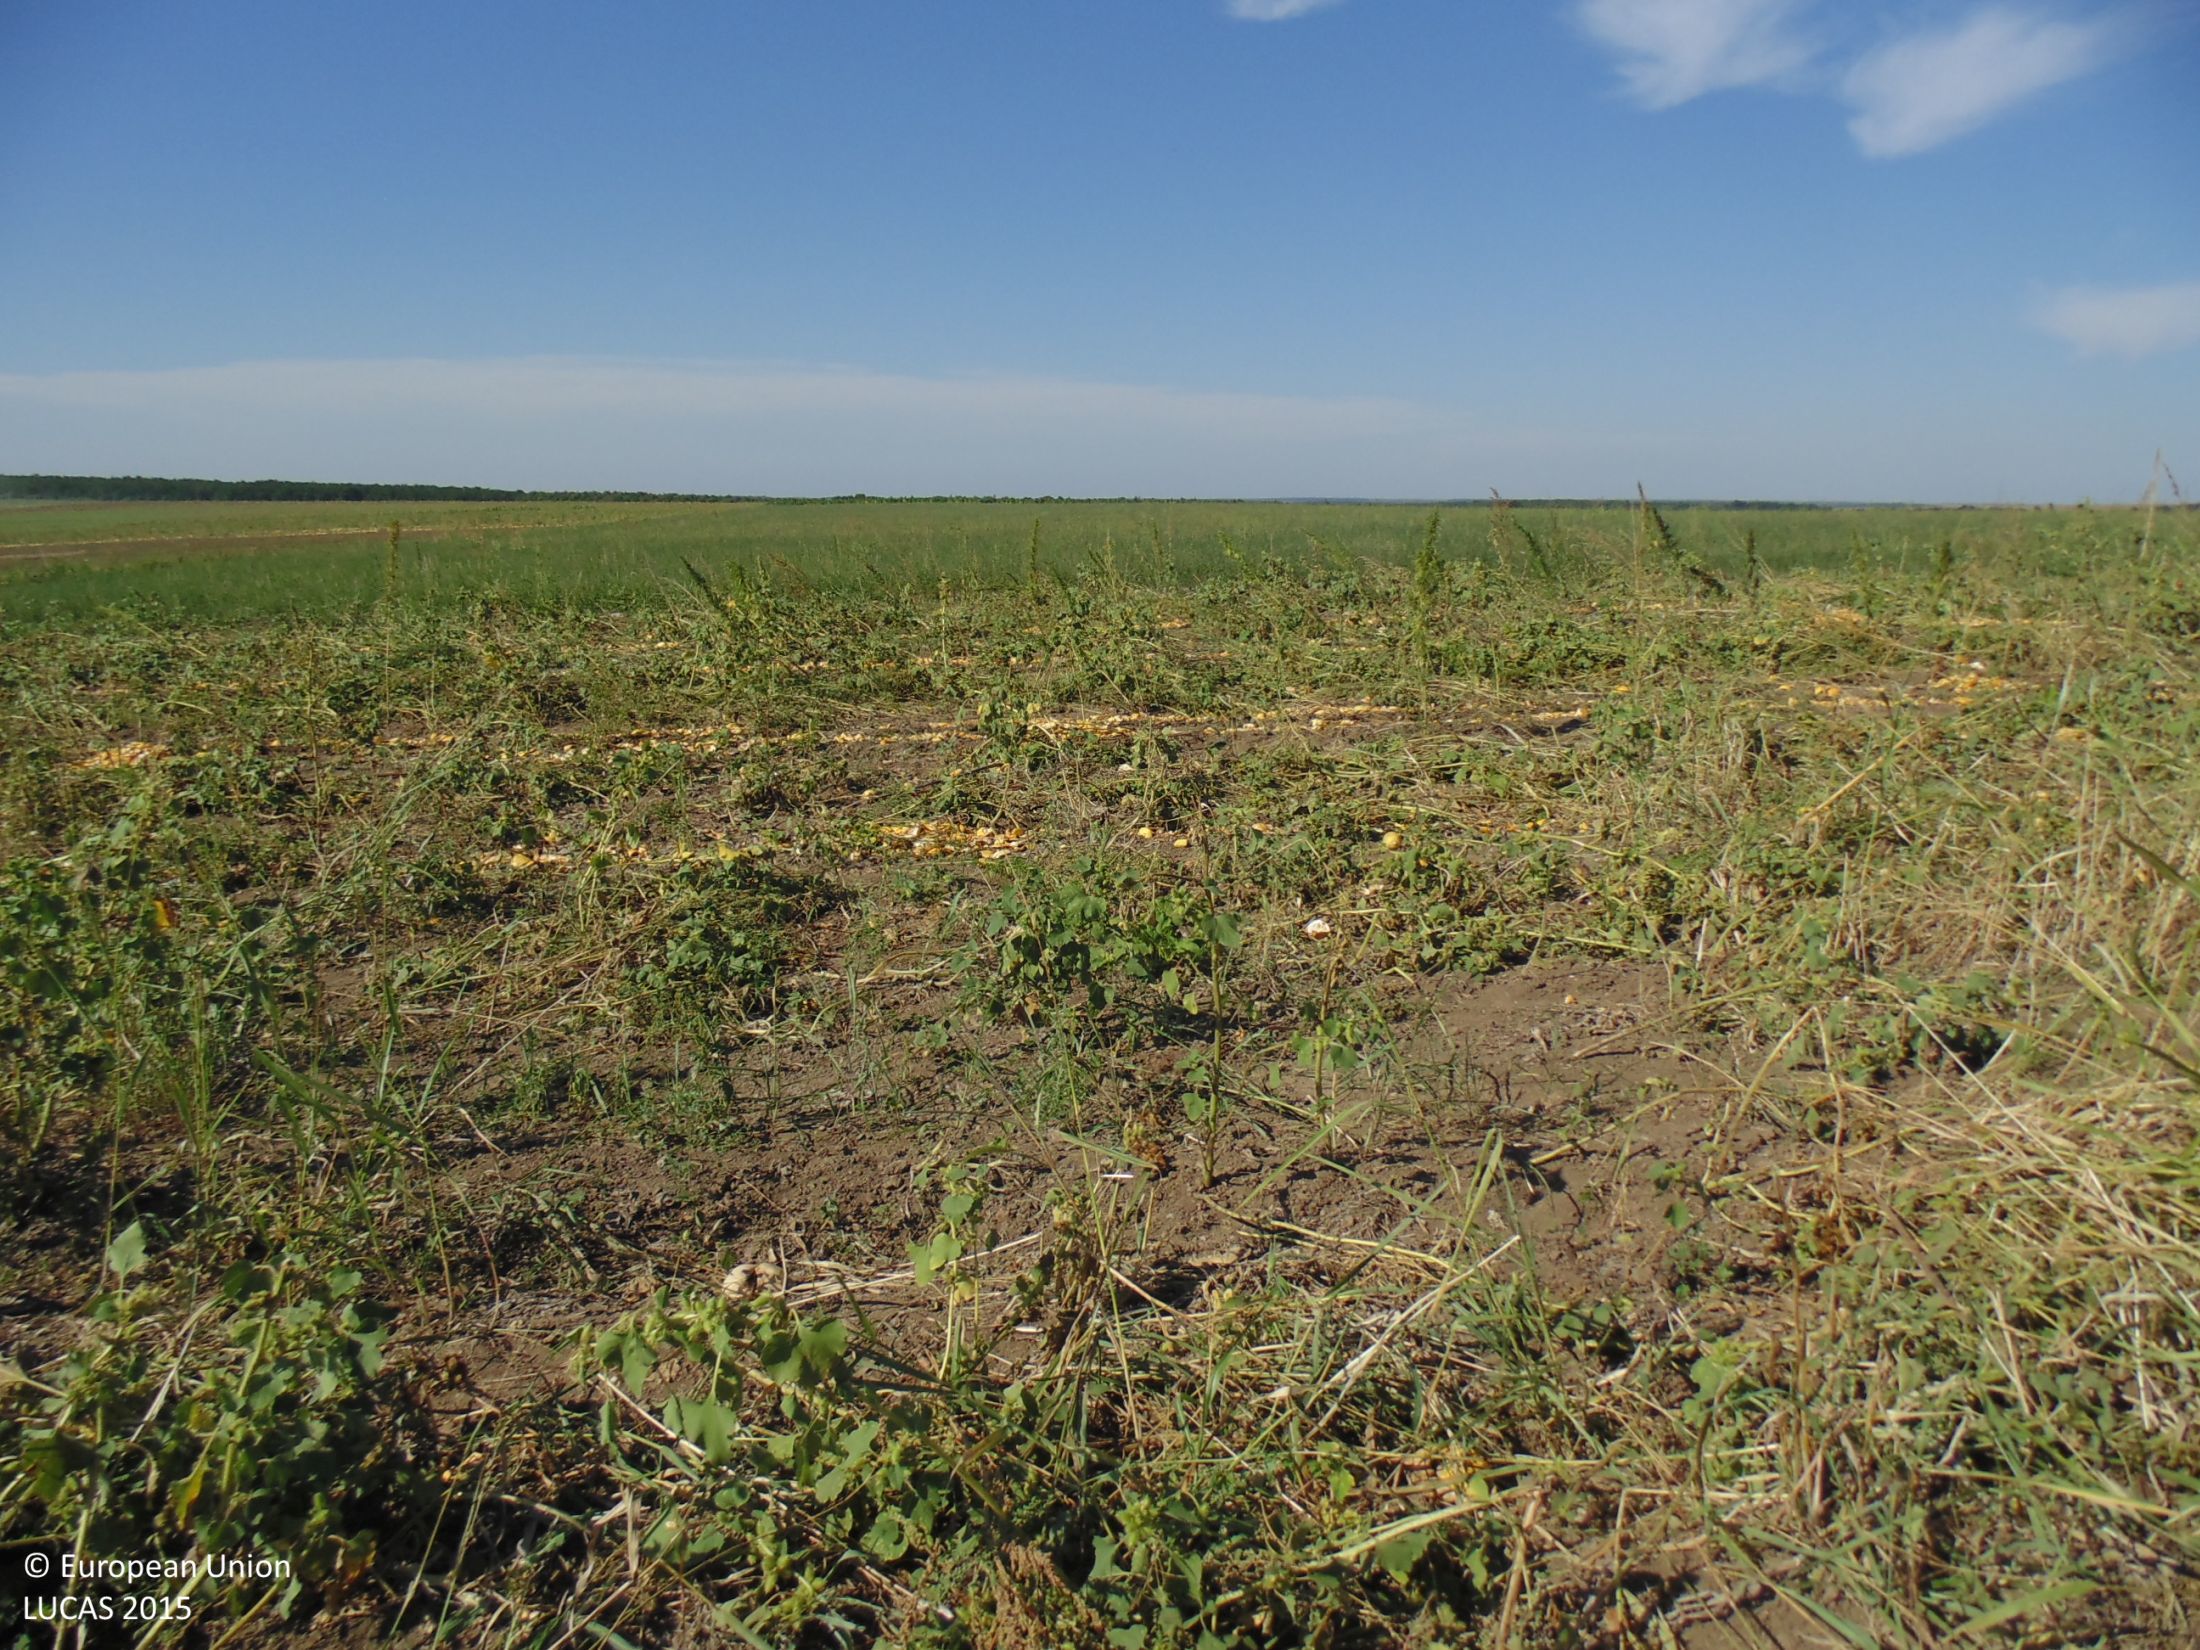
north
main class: Cropland
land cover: Other fresh vegetables
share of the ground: 10 - 25 %
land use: Agriculture (excluding fallow land and kitchen gardens)
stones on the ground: < 10 %
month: September
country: BG
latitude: 43.8804
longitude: 26.9601
